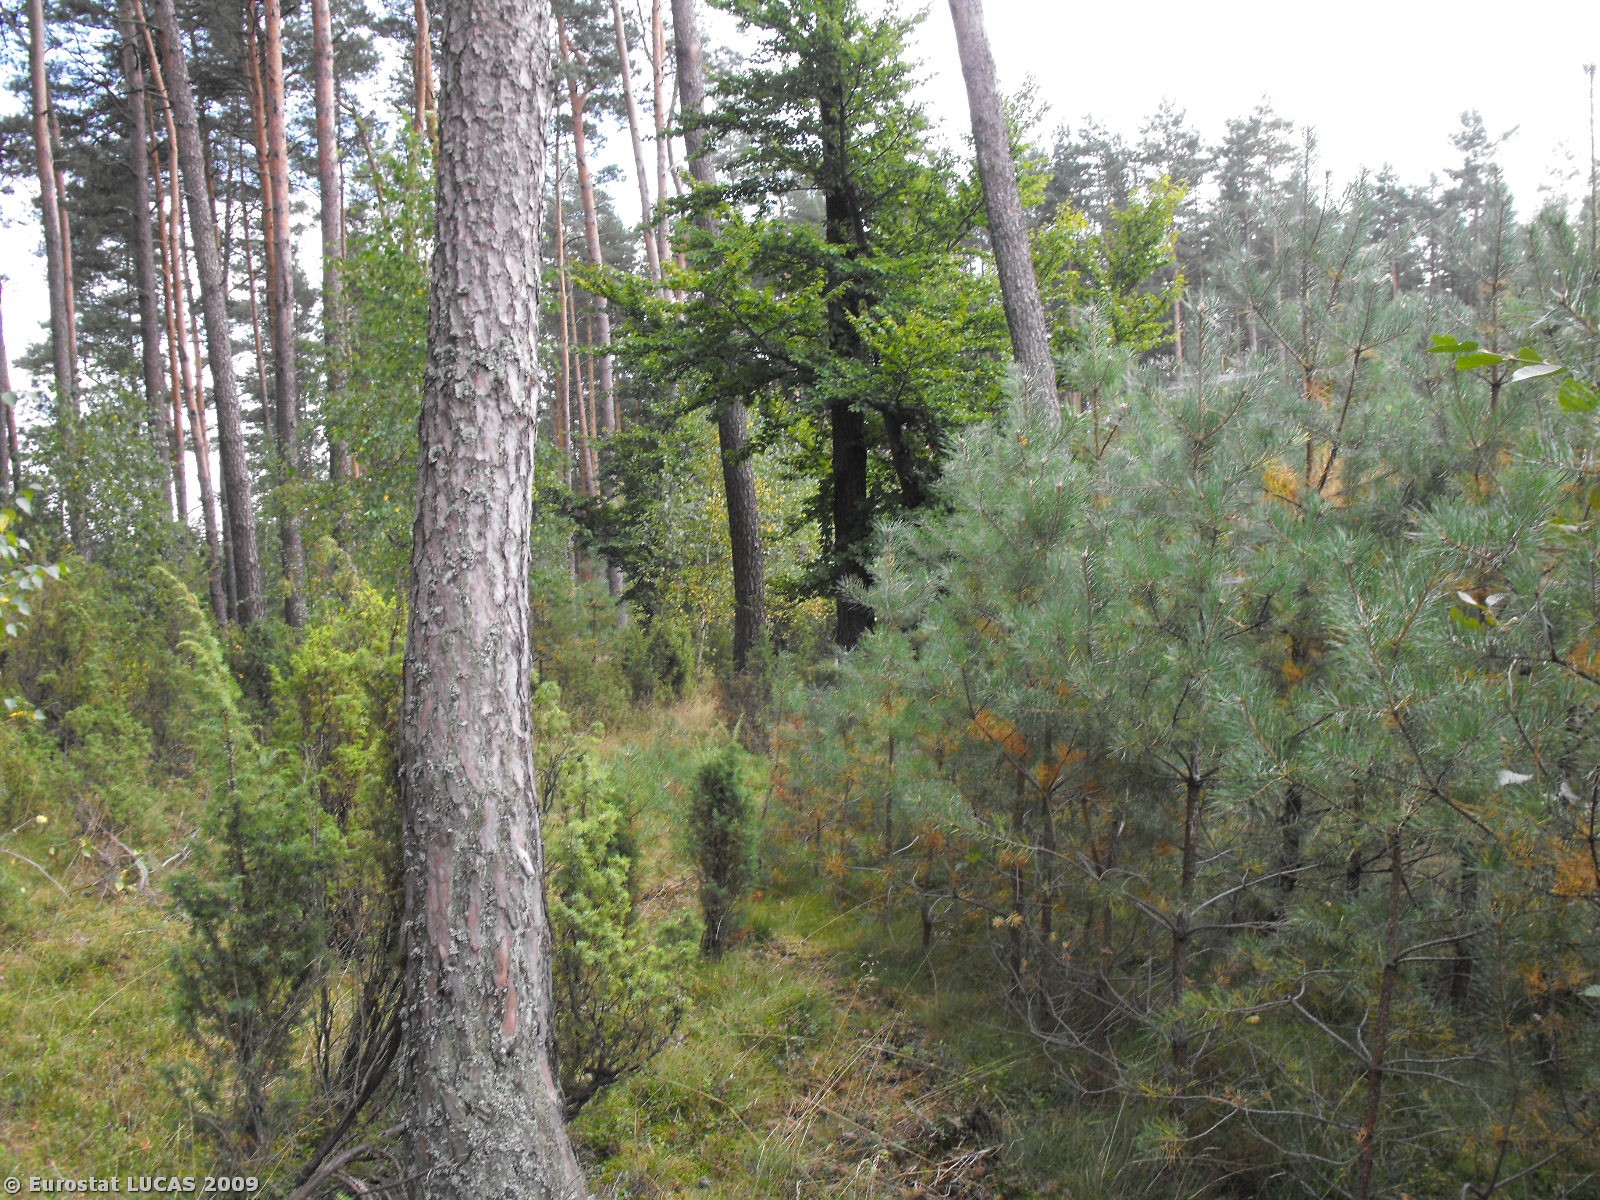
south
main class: Woodland
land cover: Coniferous woodland
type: hemiboreal forest and nemoral coniferous forest and mixed broadleaved-coniferous forest
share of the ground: > 75 %
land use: Forestry
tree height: > 5 m
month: September
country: PL
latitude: 53.0046
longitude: 16.2801
